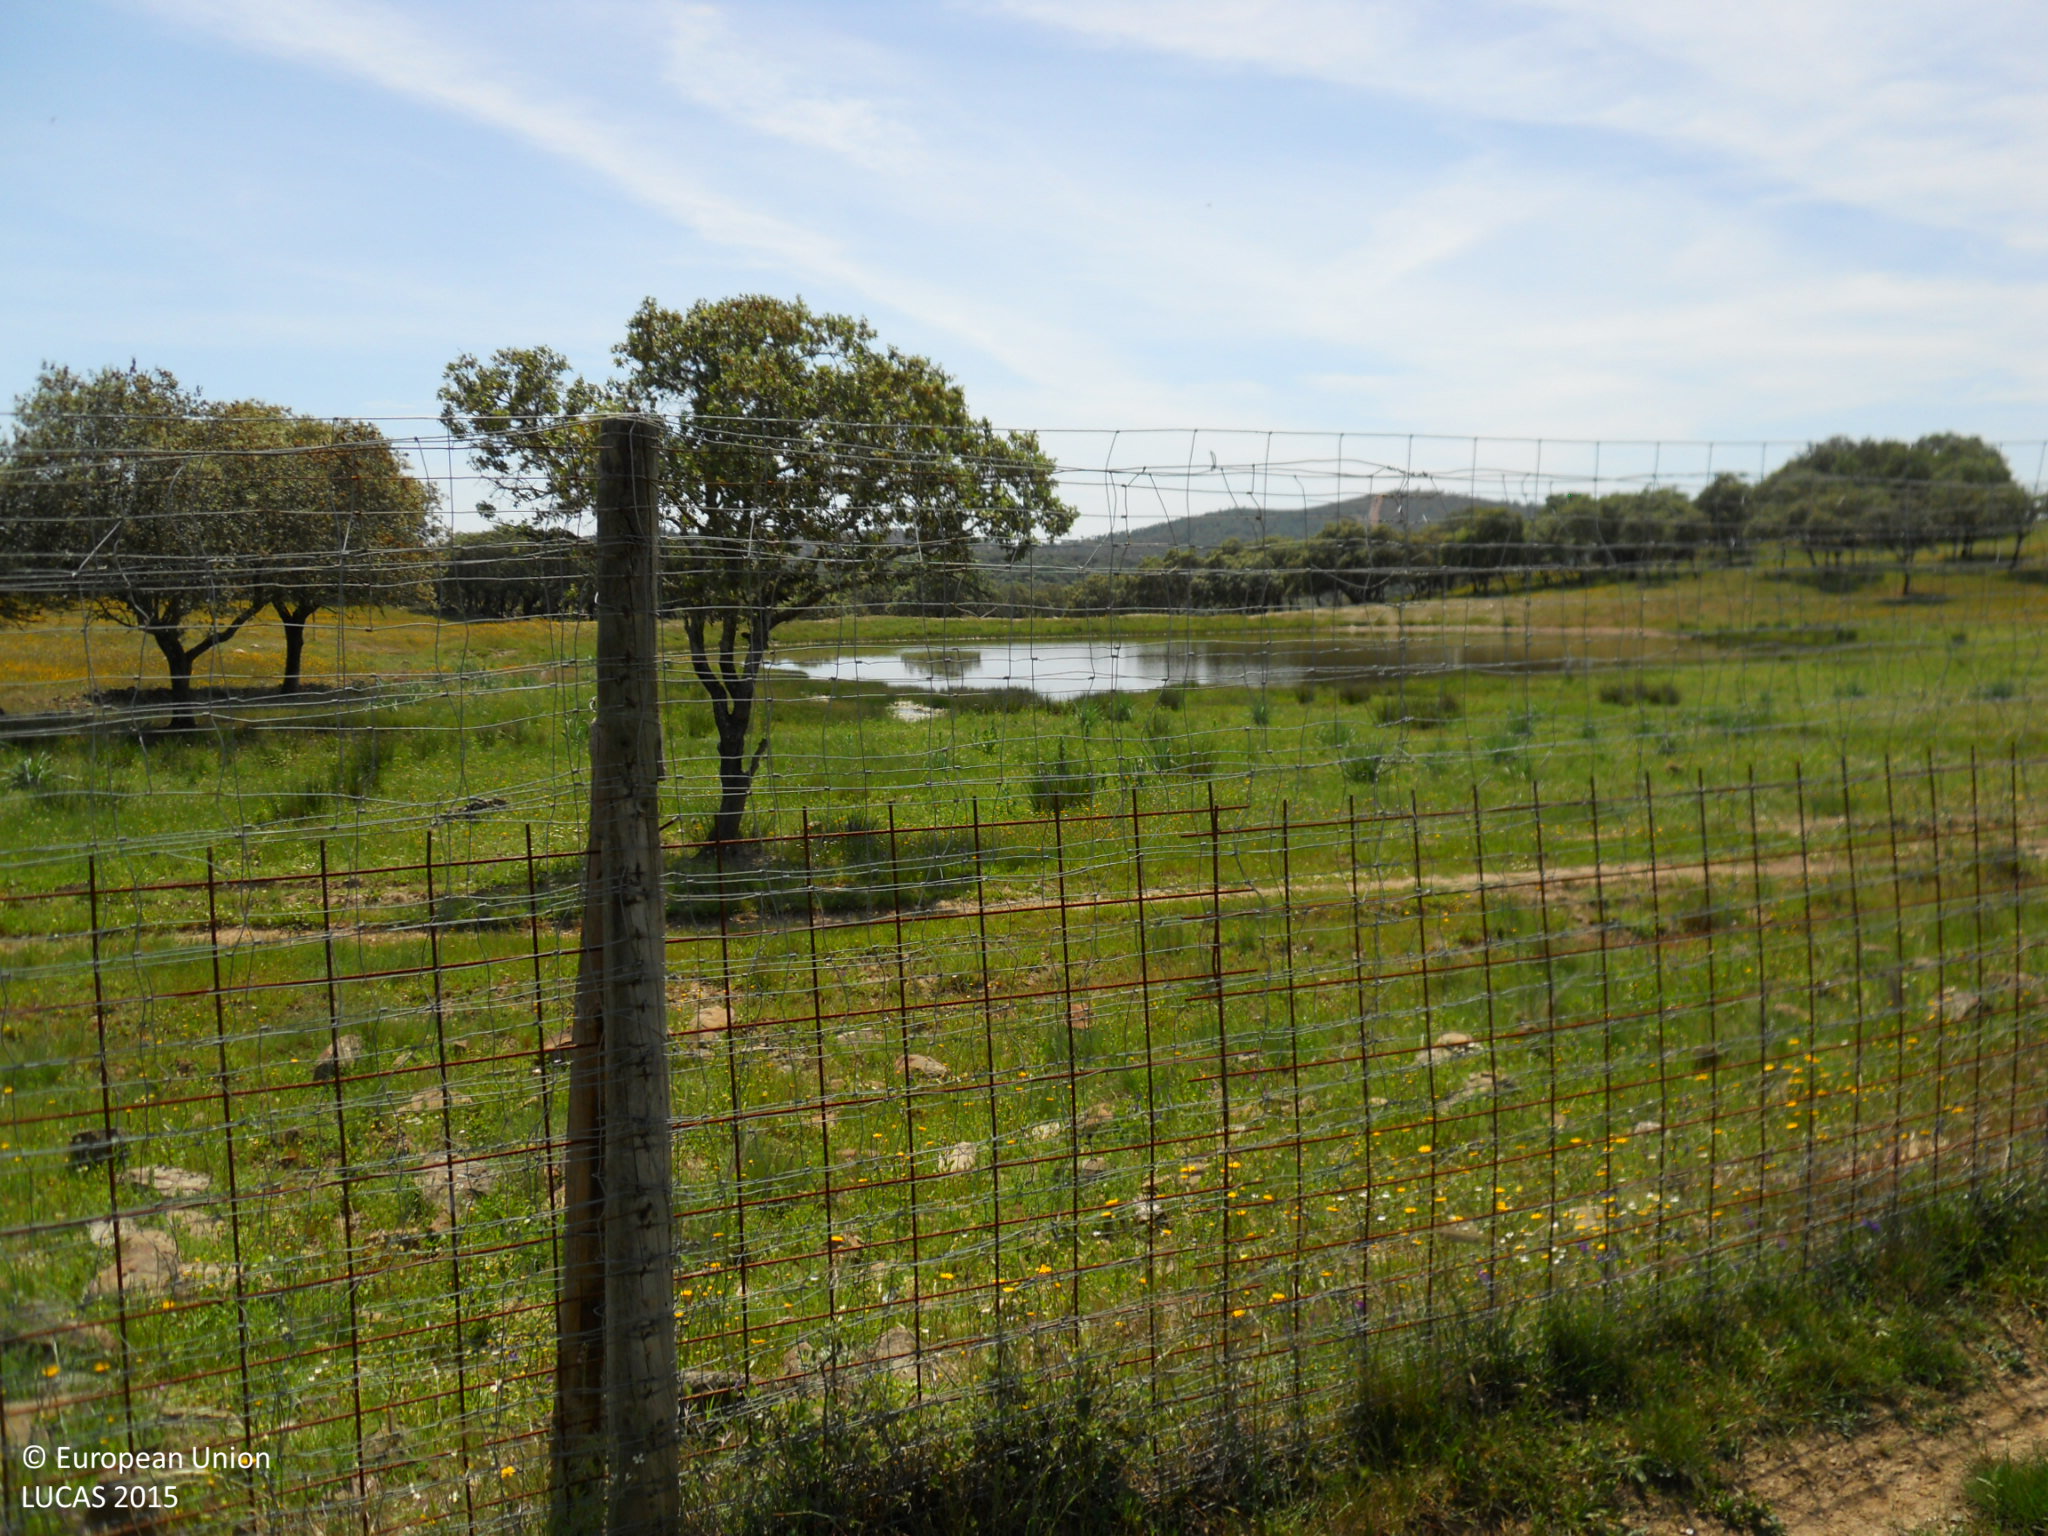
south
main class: Grassland
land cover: Grassland with sparse tree/shrub cover
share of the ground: > 75 %
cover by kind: herbaceous plants 90 %, broadleaved forest trees 5 %, shrubs 5 %
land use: Agriculture (excluding fallow land and kitchen gardens)
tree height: < 5 m
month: April
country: ES
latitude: 39.1680
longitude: -6.8433
